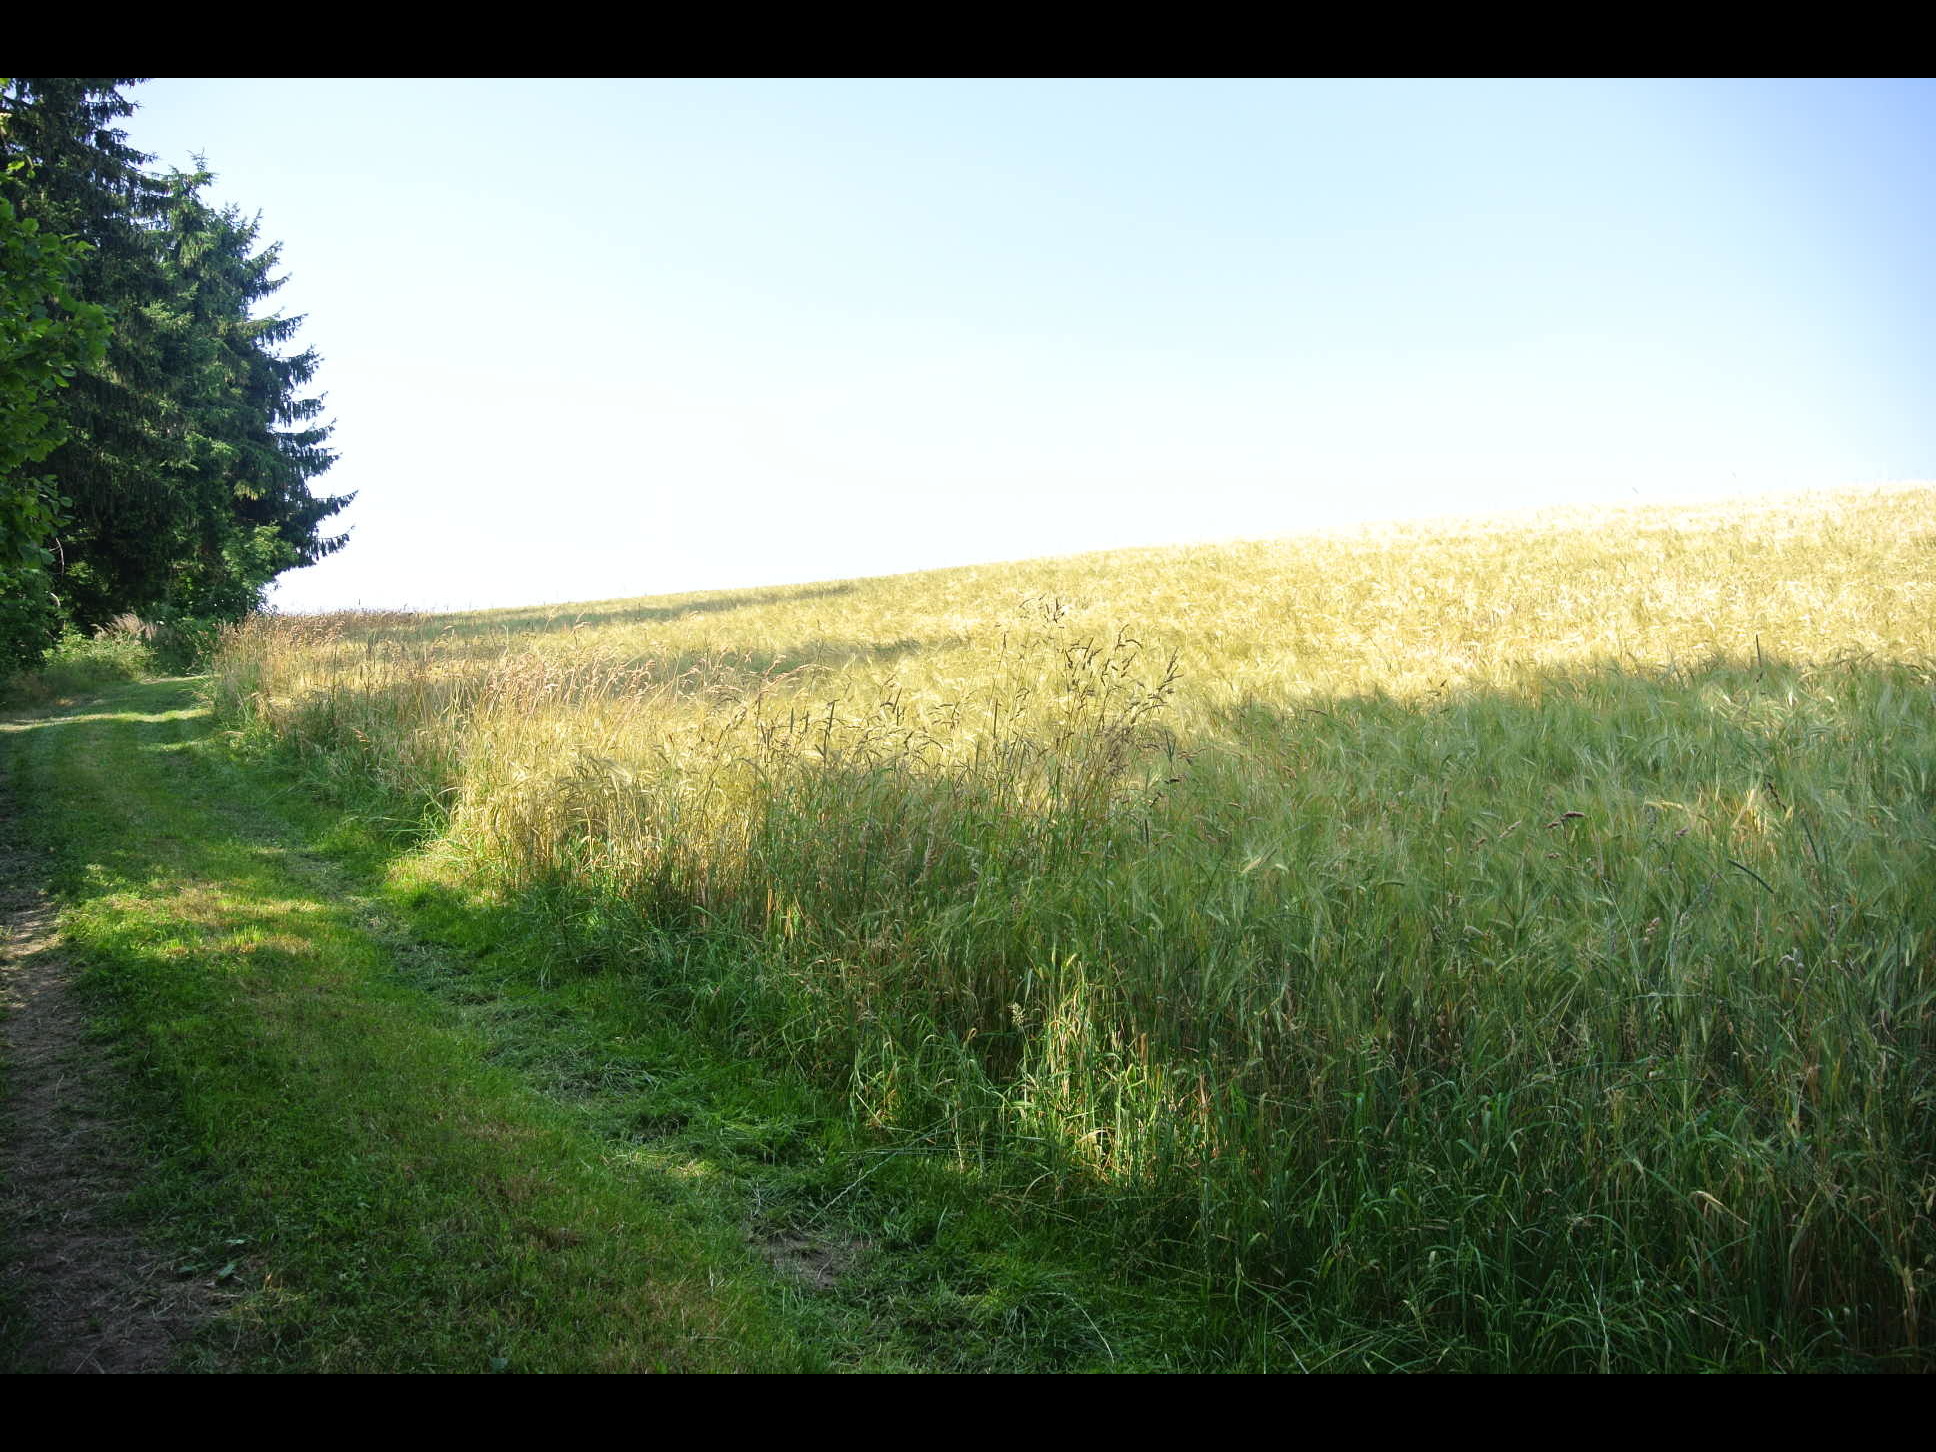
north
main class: Woodland
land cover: Broadleaved woodland
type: floodplain forest
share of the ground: > 75 %
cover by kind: broadleaved forest trees 100 %
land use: Forestry
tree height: > 5 m
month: July
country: AT
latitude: 47.5626
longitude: 16.1832
